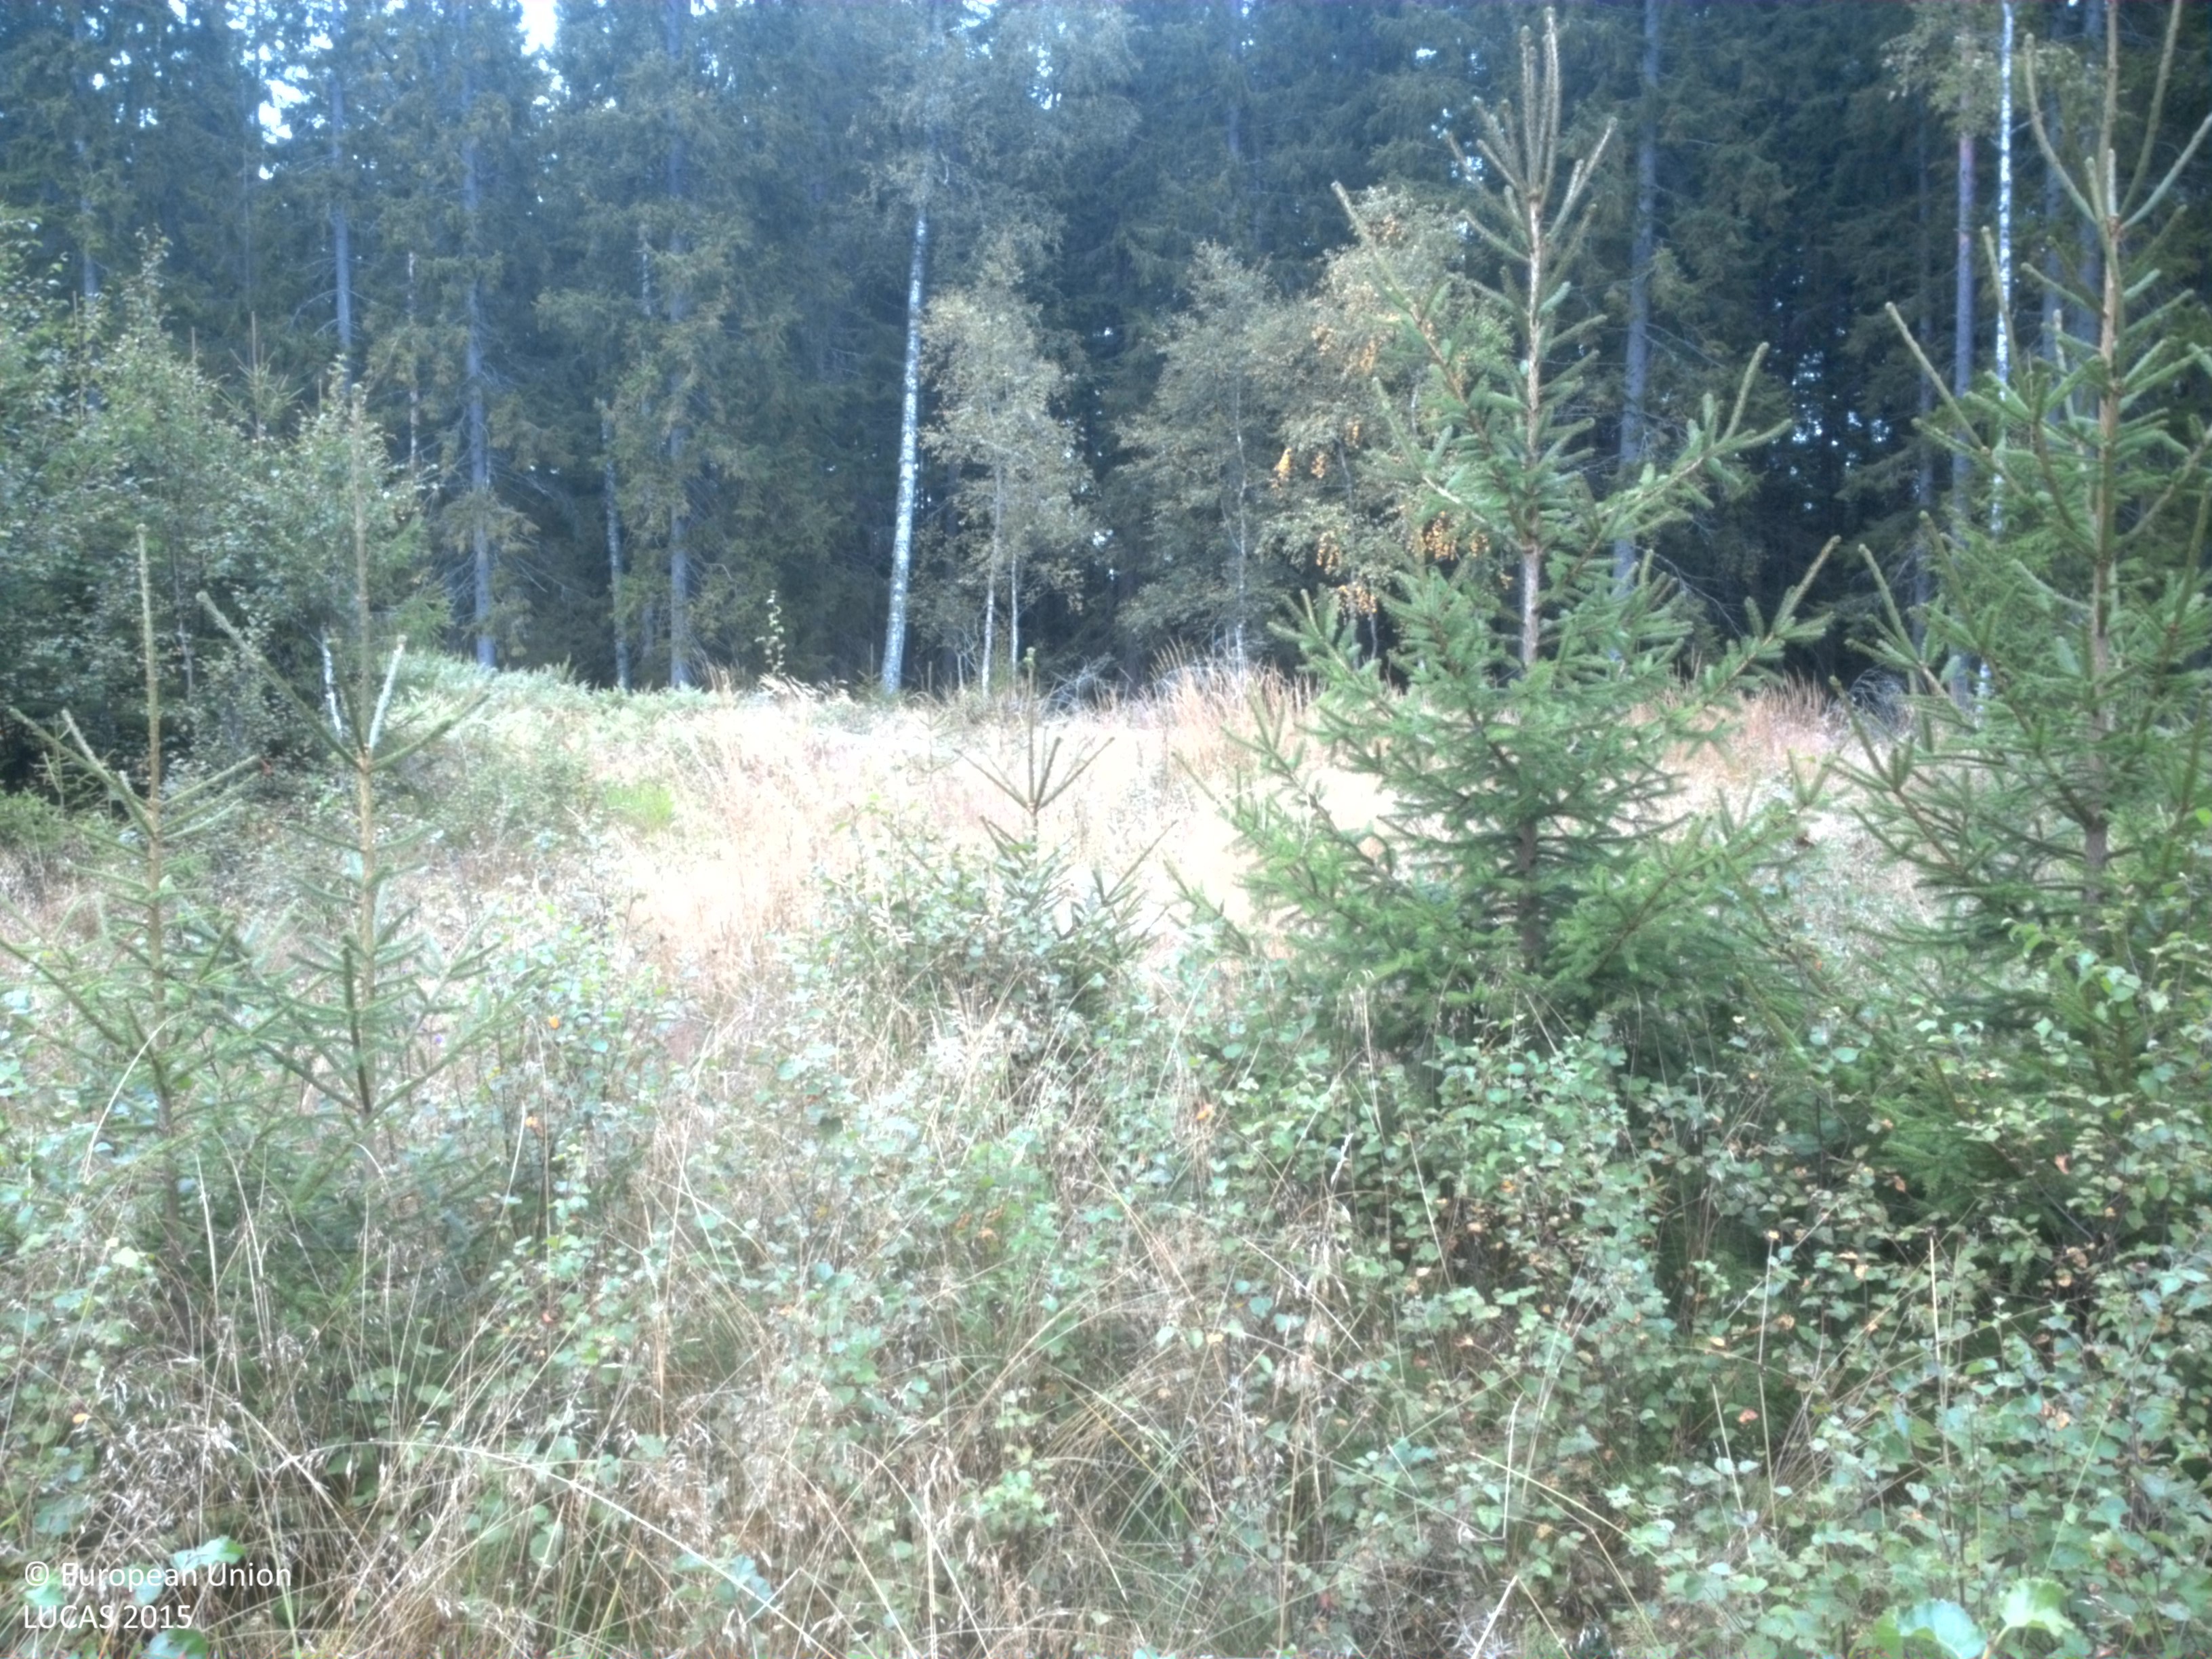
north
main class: Woodland
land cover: Spruce dominated mixed woodland
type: boreal forest
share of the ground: > 75 %
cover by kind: broadleaved forest trees 55 %, coniferous forest trees 20 %, herbaceous plants 20 %, shrubs 5 %
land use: Forestry
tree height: < 5 m
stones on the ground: < 10 %
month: August
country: SE
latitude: 59.6853
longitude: 15.7277
